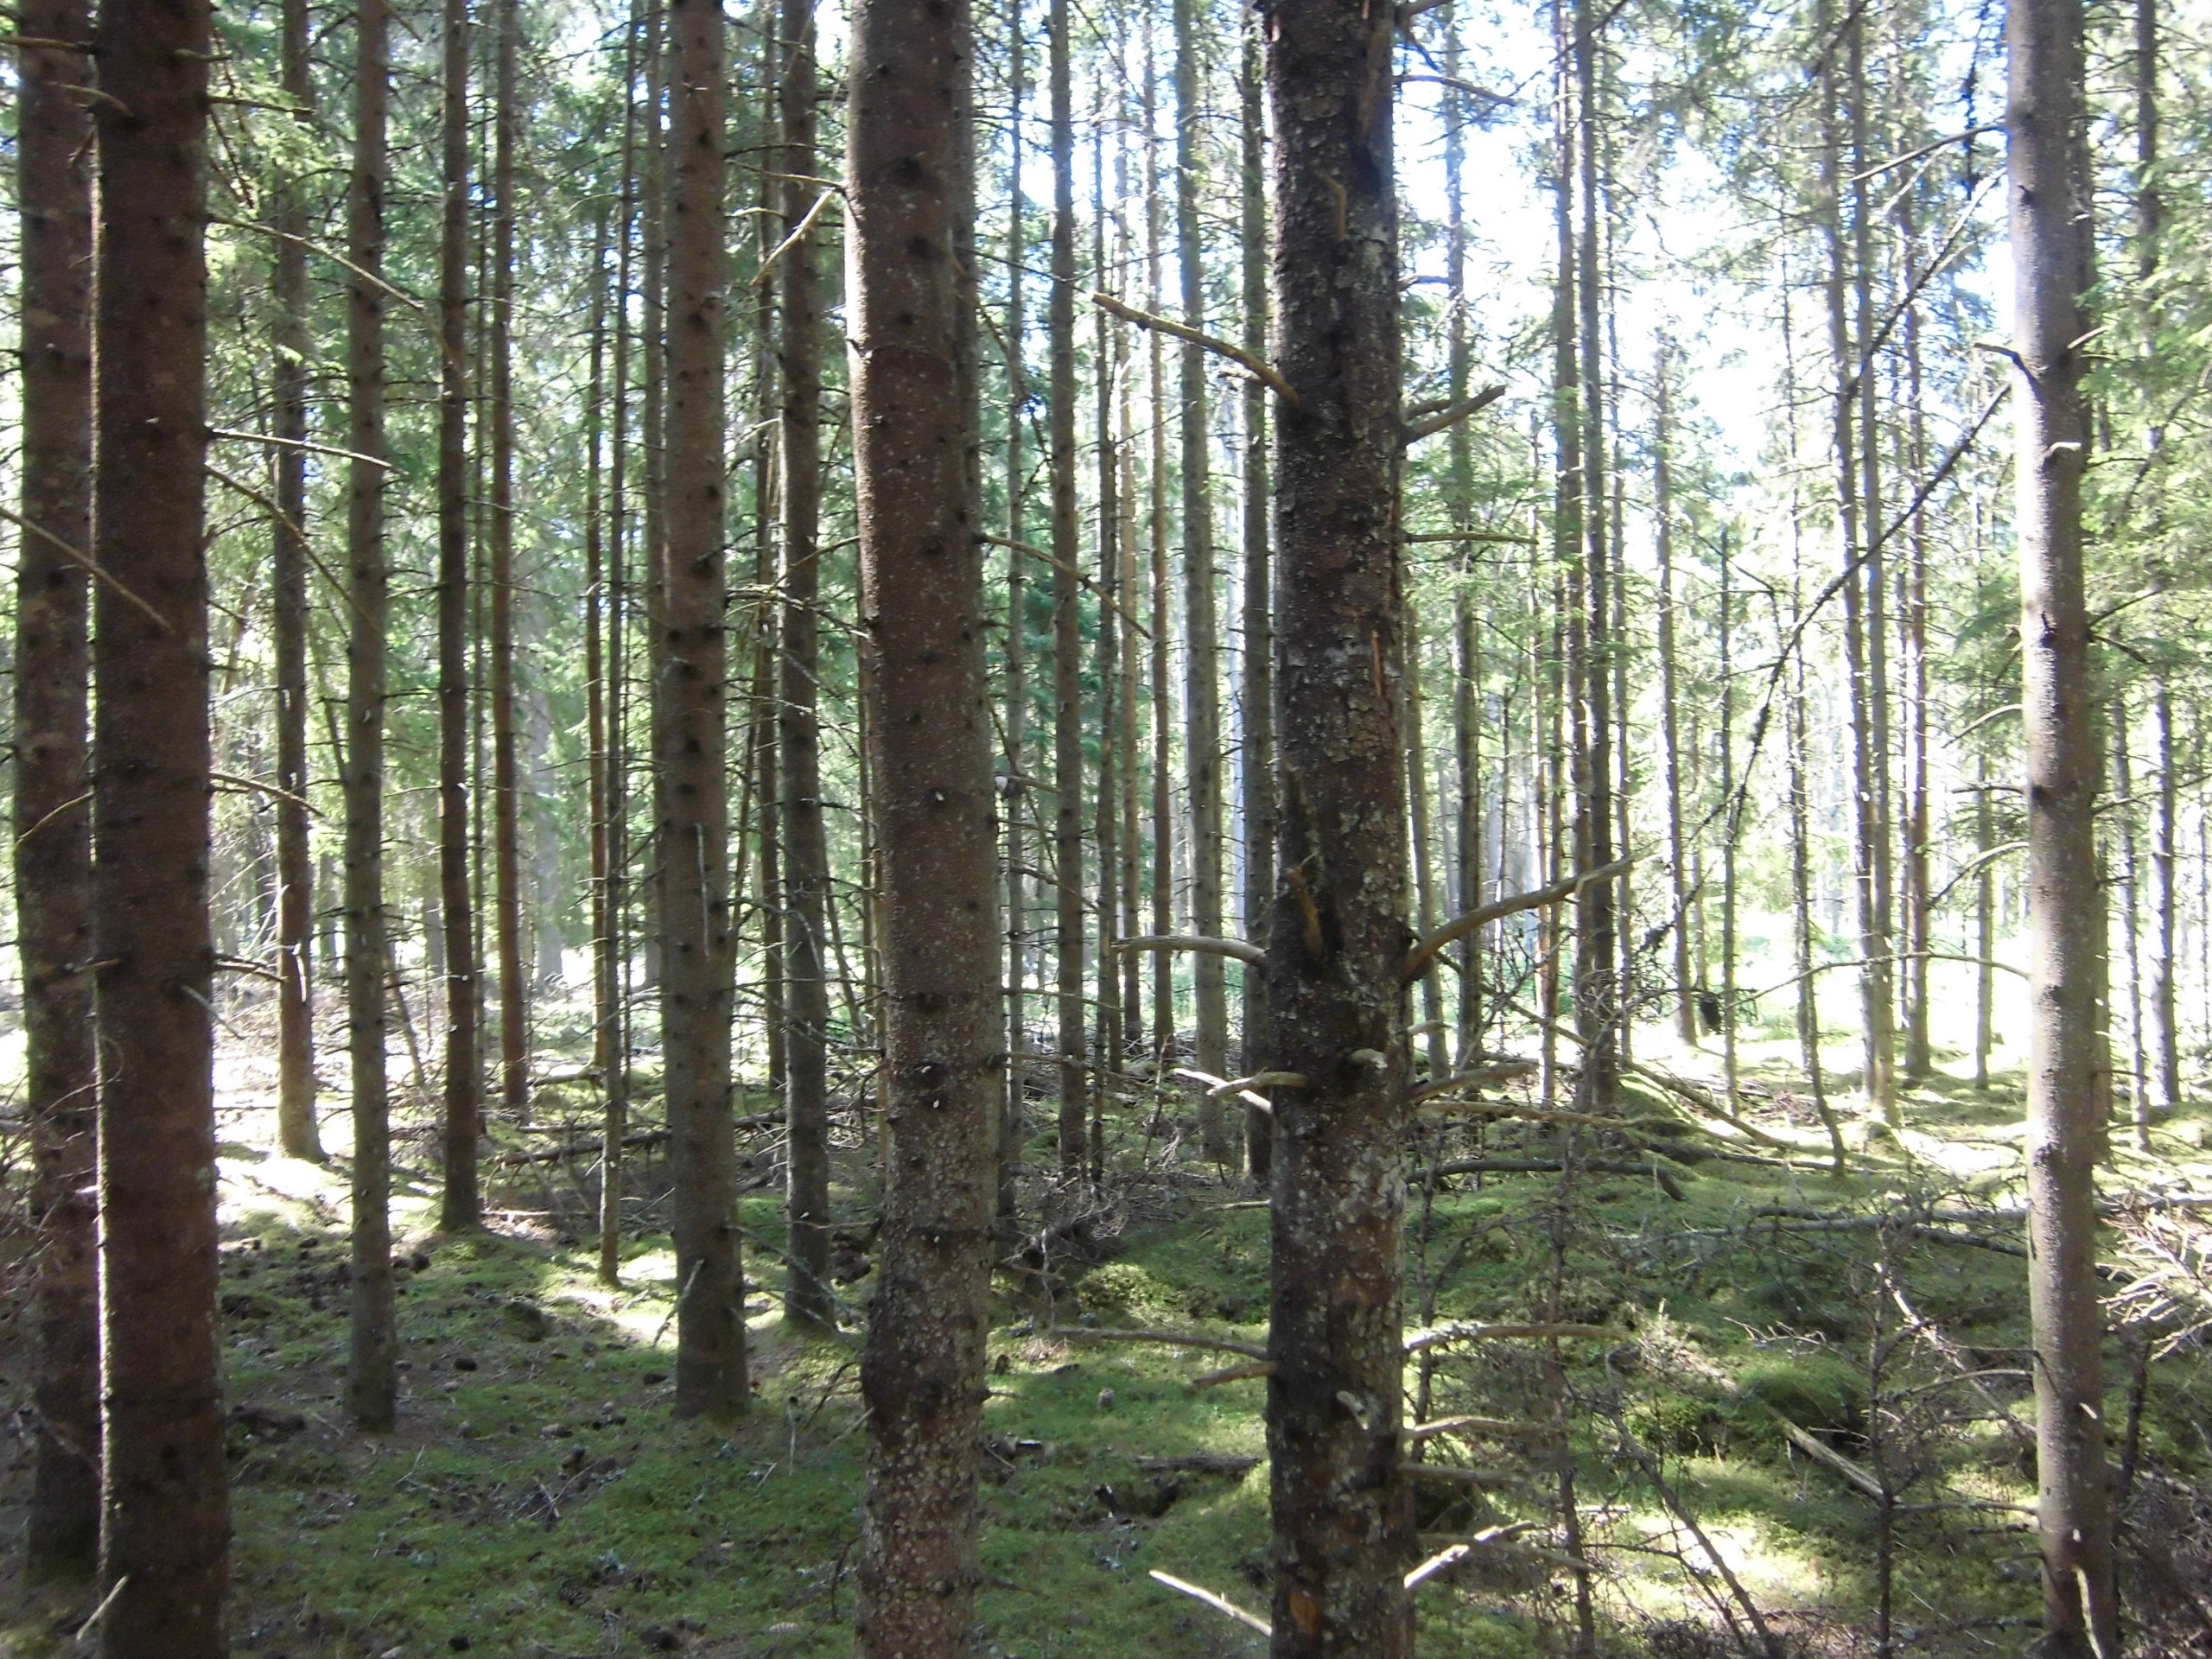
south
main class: Woodland
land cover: Spruce dominated coniferous woodland
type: boreal forest
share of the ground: 50 - 75 %
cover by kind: coniferous forest trees 65 %, lichens and mosses 20 %, unconsolidated bare surface 15 %
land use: Forestry
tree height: > 5 m
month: July
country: SE
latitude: 57.2717
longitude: 14.7227
